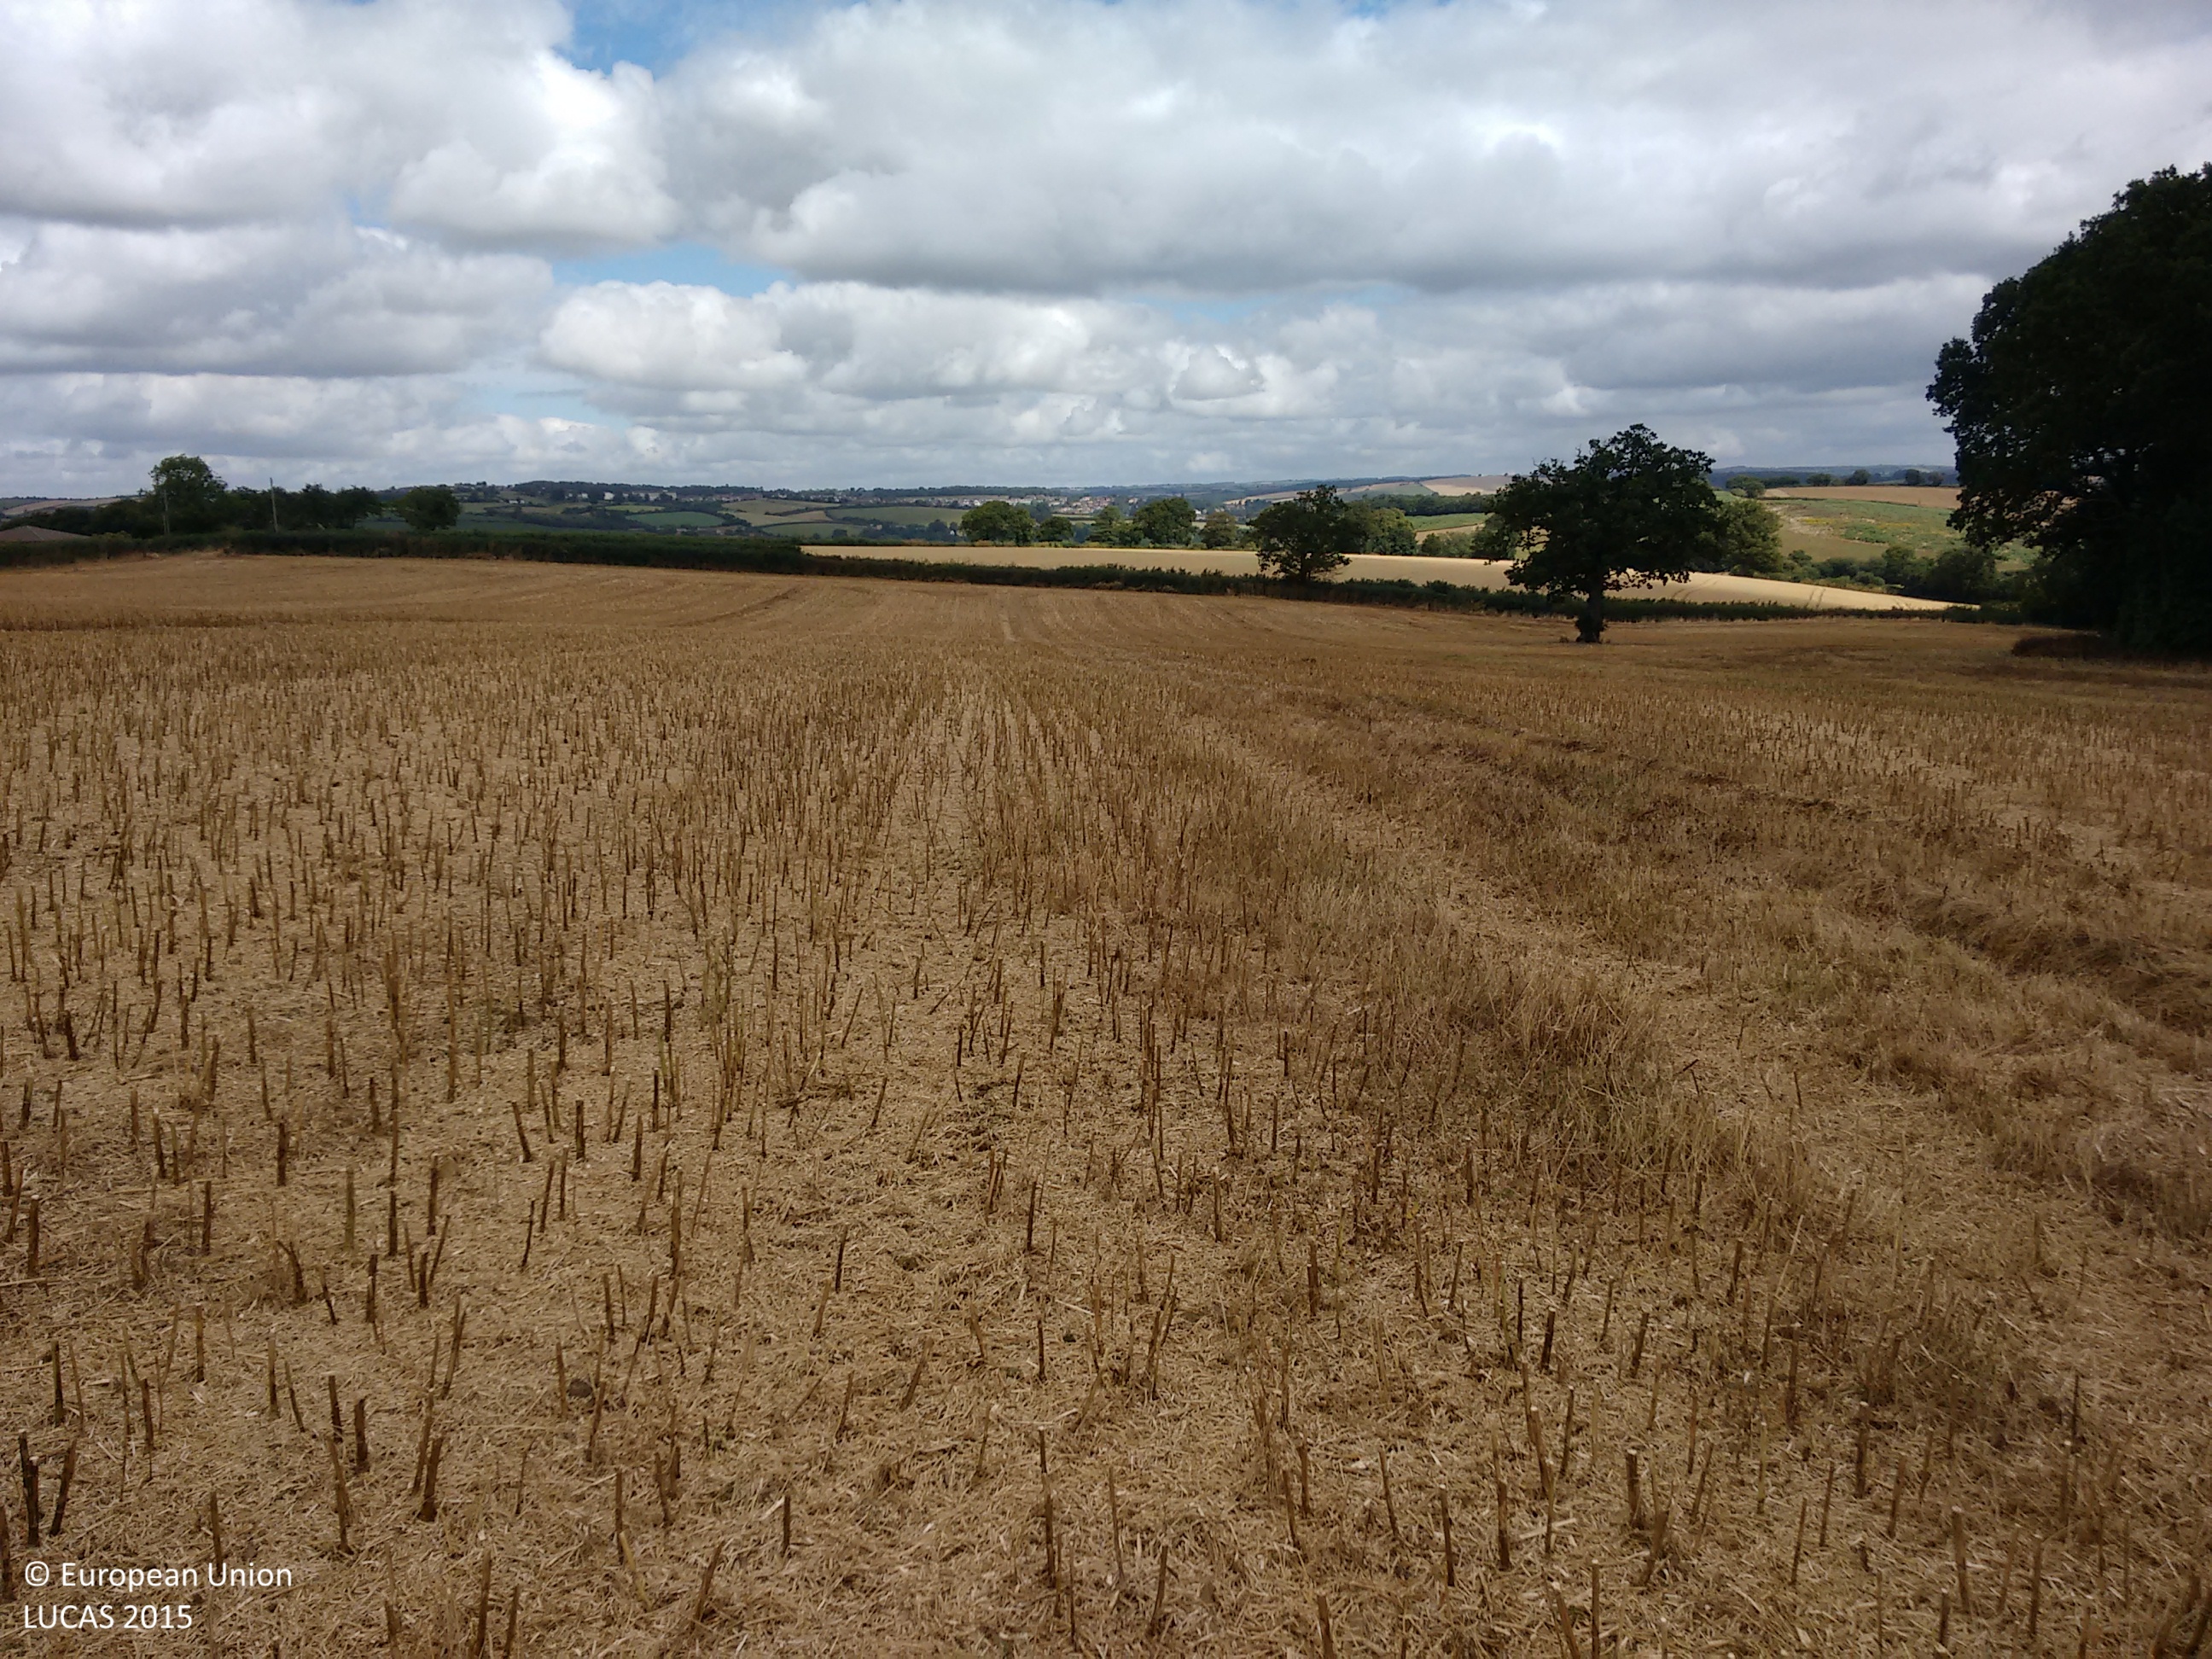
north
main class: Cropland
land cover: Rape and turnip rape
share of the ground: 10 - 25 %
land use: Agriculture (excluding fallow land and kitchen gardens)
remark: Harvested field
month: August
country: GB
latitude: 50.7625
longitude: -3.6546
